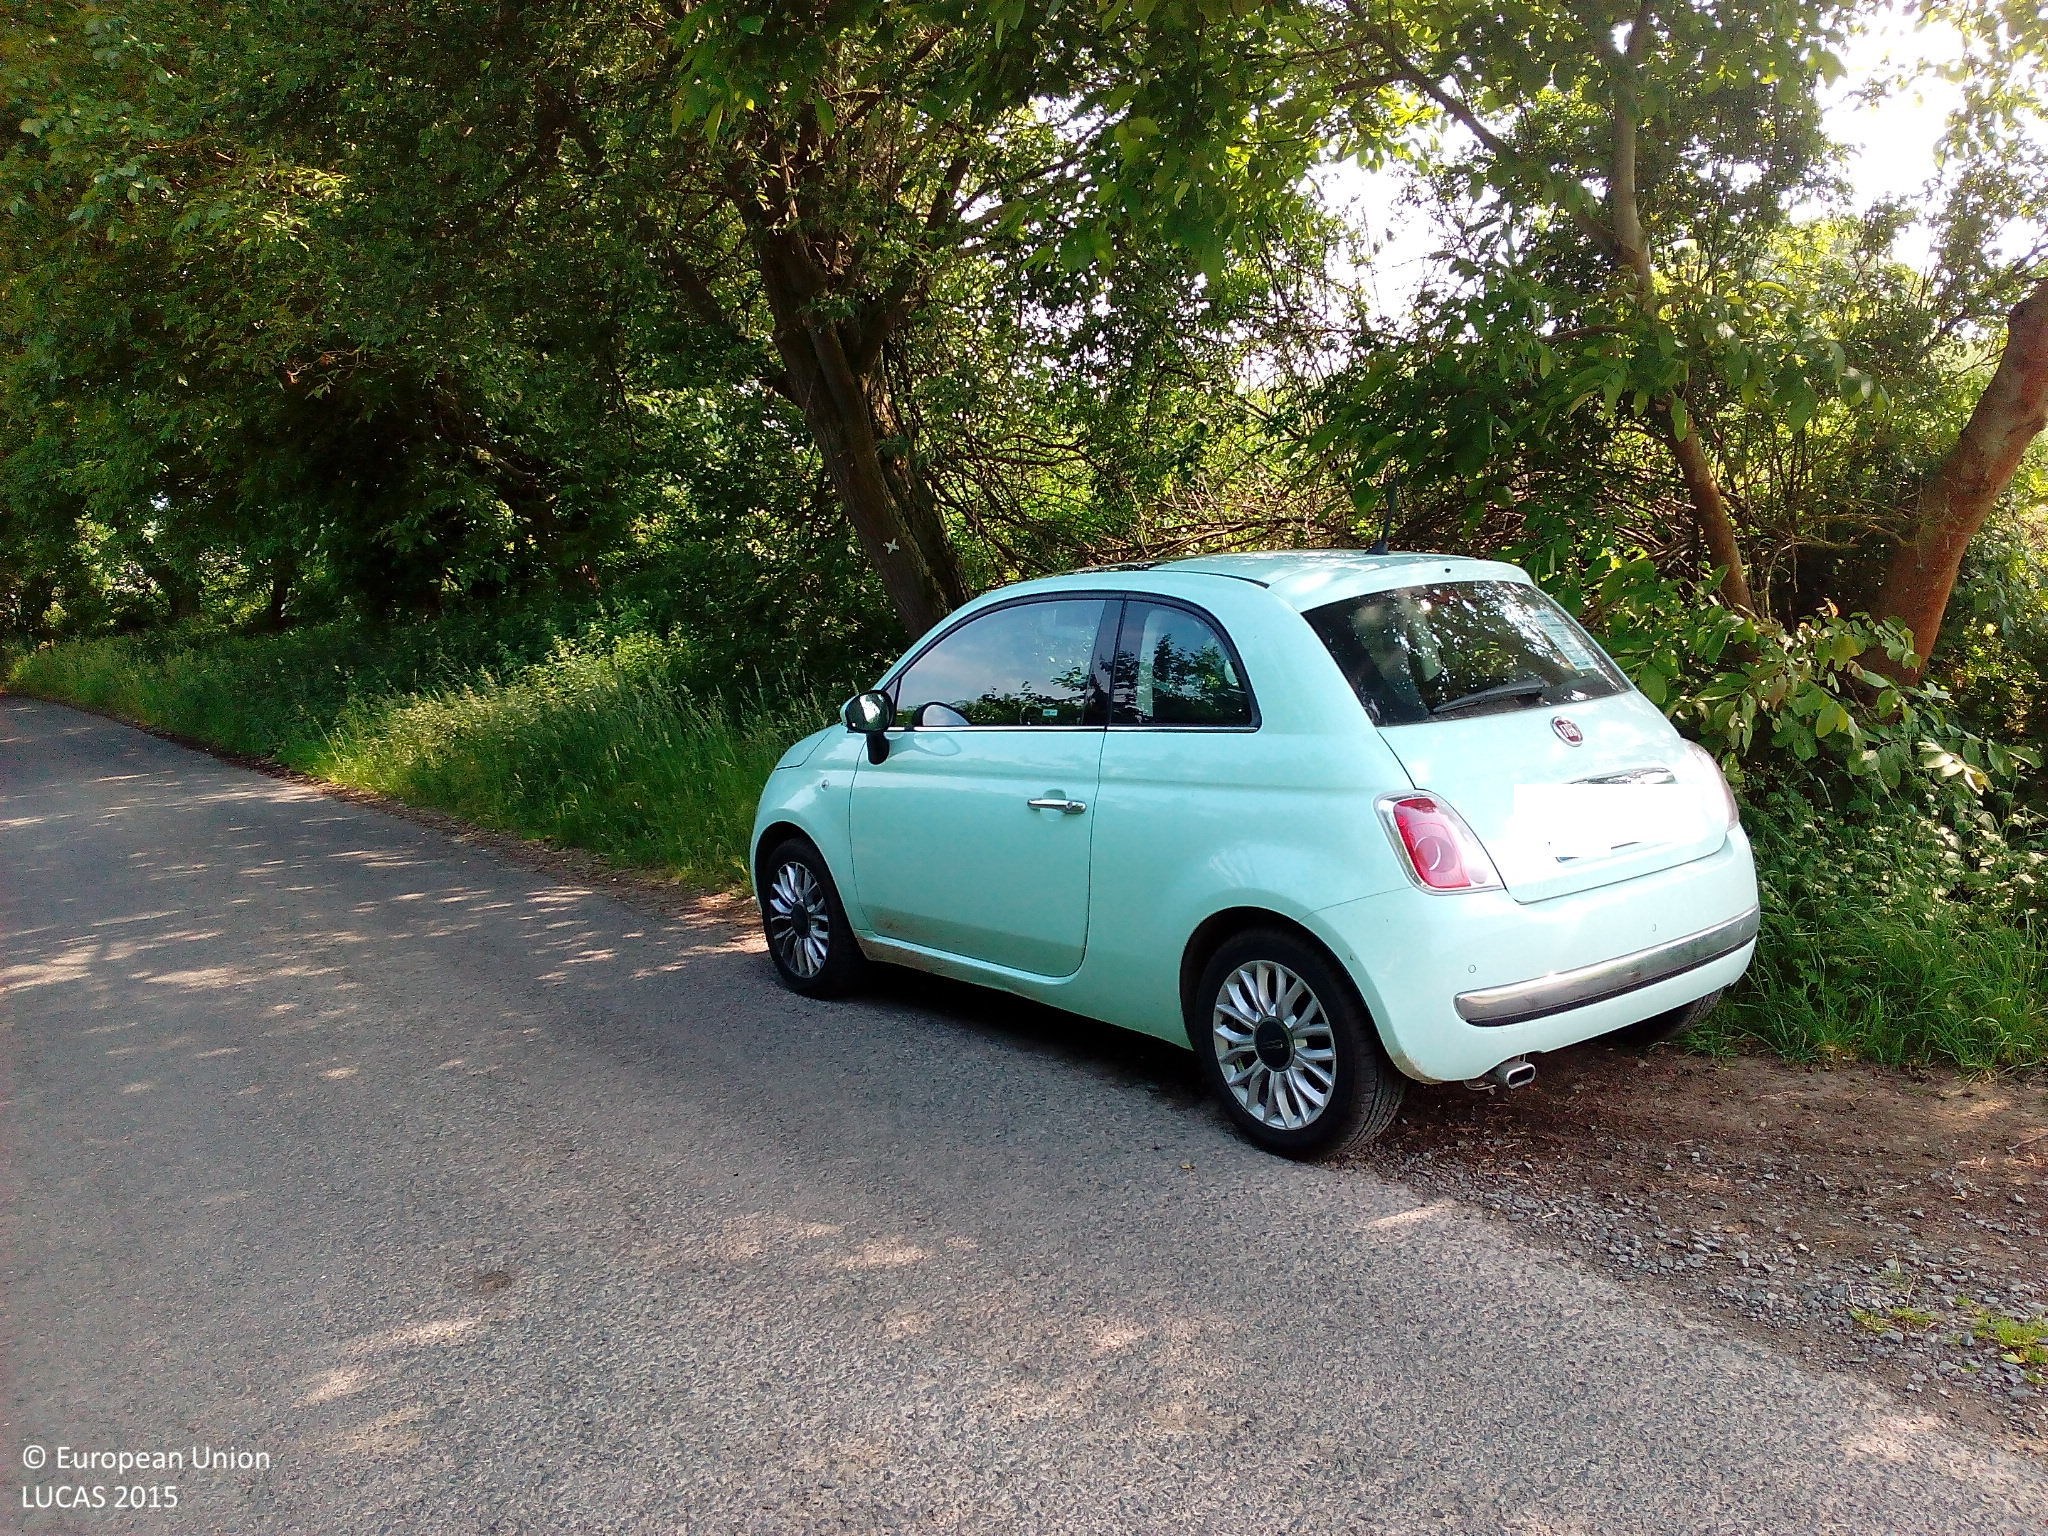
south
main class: Woodland
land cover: Broadleaved woodland
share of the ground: > 75 %
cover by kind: broadleaved forest trees 100 %
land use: Forestry
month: June
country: DE
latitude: 51.1893
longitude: 9.3563
